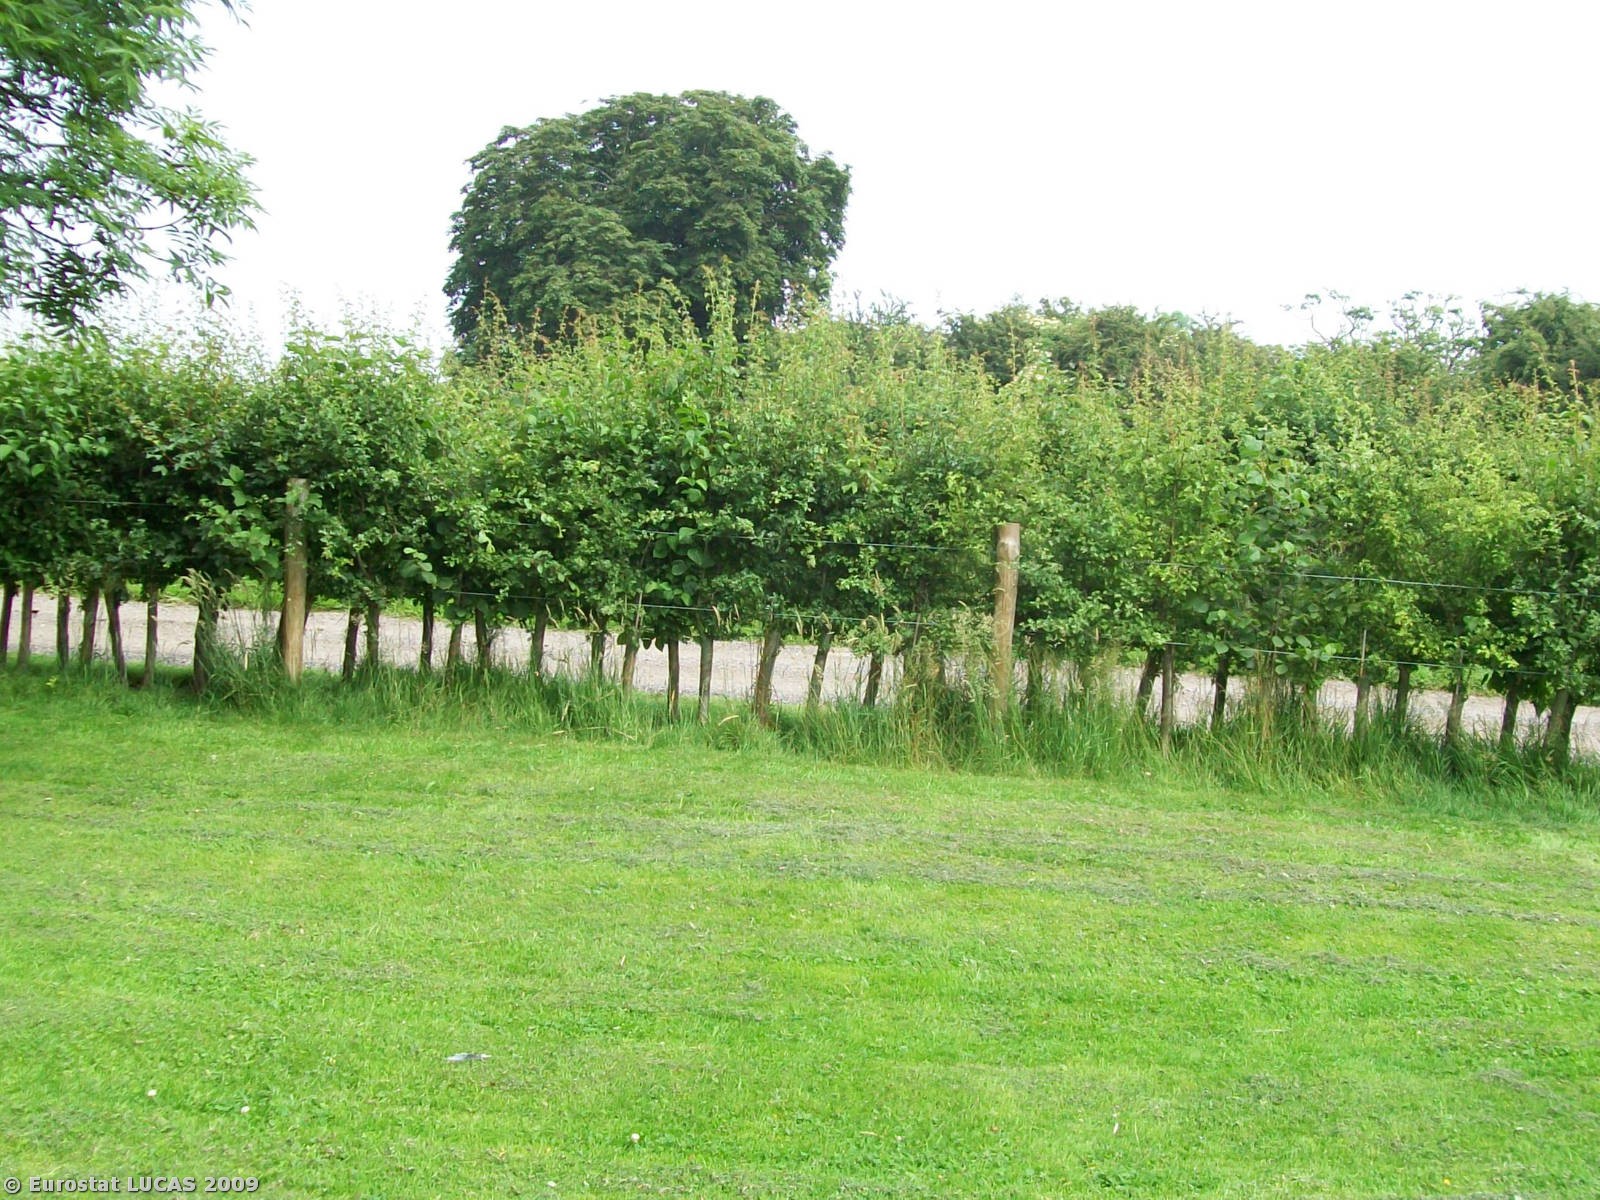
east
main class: Grassland
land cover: Grassland with sparse tree/shrub cover
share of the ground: < 10 %
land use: Holiday camps
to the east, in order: Grassland with sparse tree/shrub cover; Fences; Managed hedges; Grass margins; Tracks; Grass margins; Managed hedges; Fences; Grassland without tree/shrub cover; Abandoned hedges; Grassland without tree/shrub cover; Fences; Managed hedges; Grass margins; Tracks; Grass margins; Managed hedges; Fences; Grassland without tree/shrub cover; Abandoned hedges; Inland water bodies; Grass margins; Managed hedges; Fences; Grassland without tree/shrub cover; Managed hedges; Grass margins; Paved roads, cycling and walking lanes; Grass margins; Electric lines
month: June
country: GB
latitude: 54.0875
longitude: -1.4997
